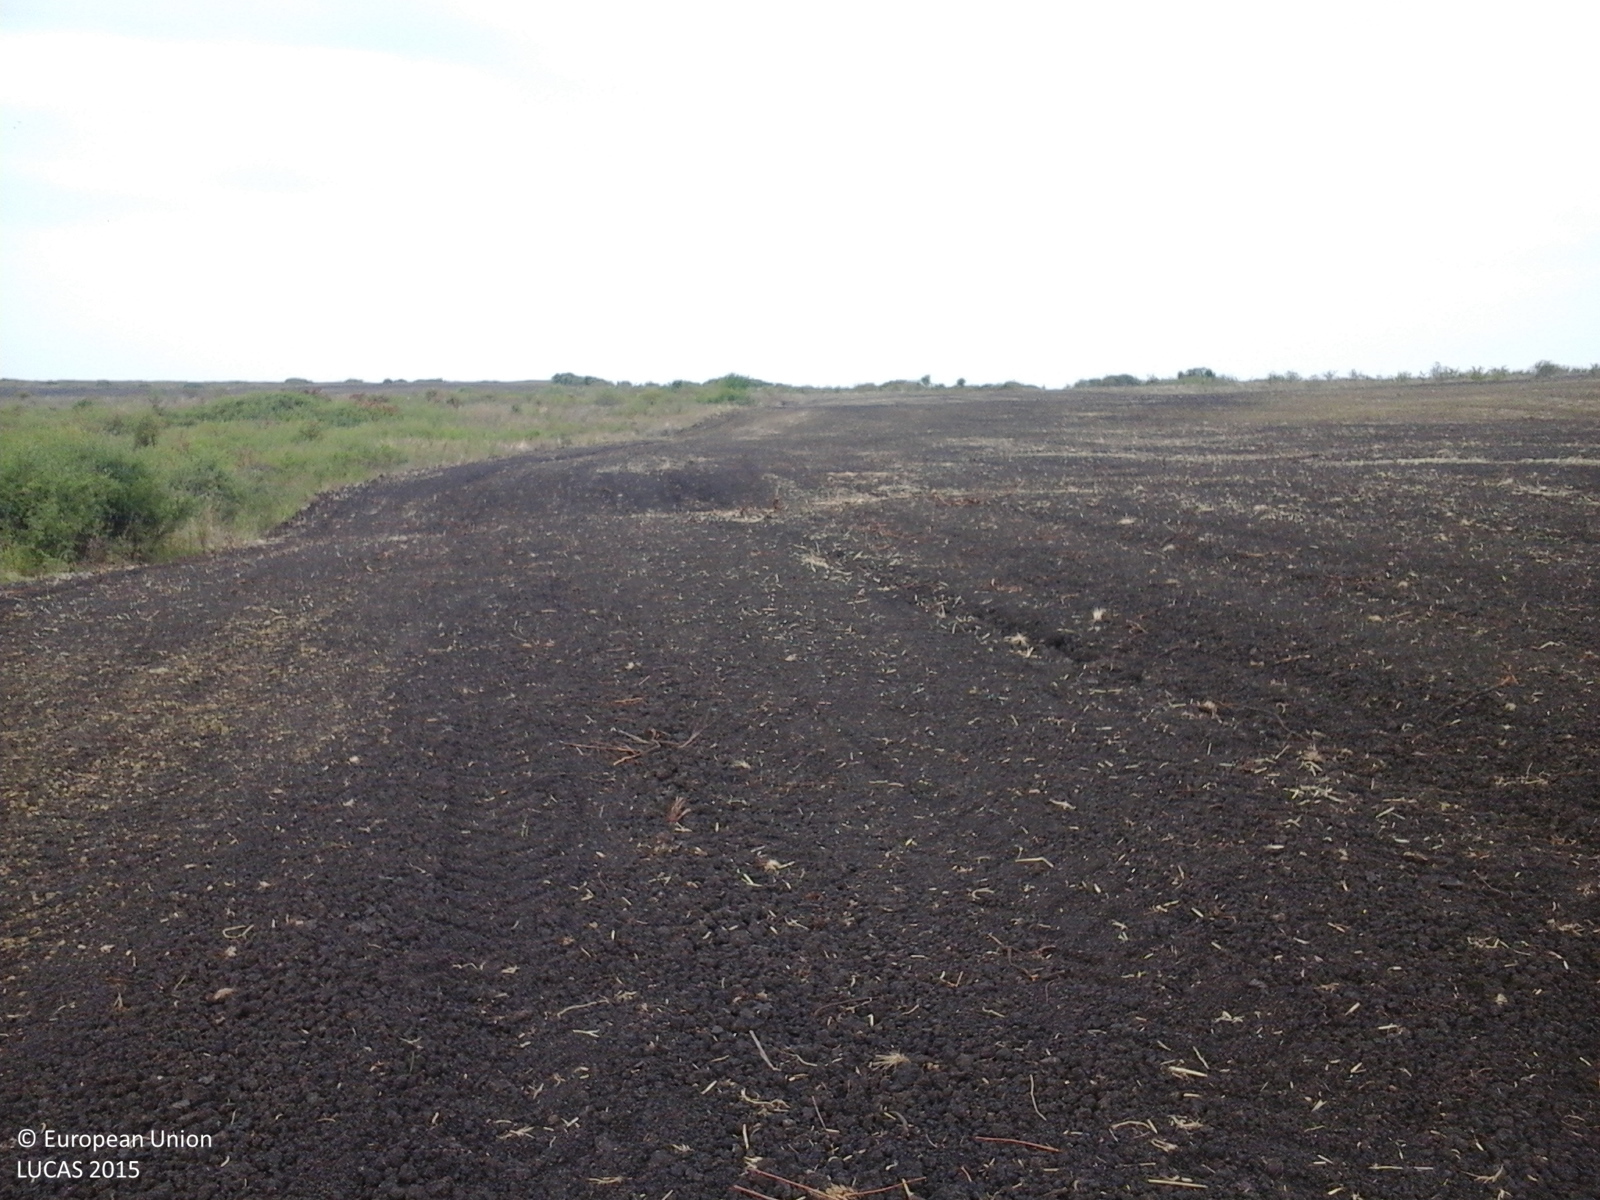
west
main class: Cropland
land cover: Common wheat
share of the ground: < 10 %
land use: Agriculture (excluding fallow land and kitchen gardens)
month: September
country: RO
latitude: 47.2785
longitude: 23.0599
